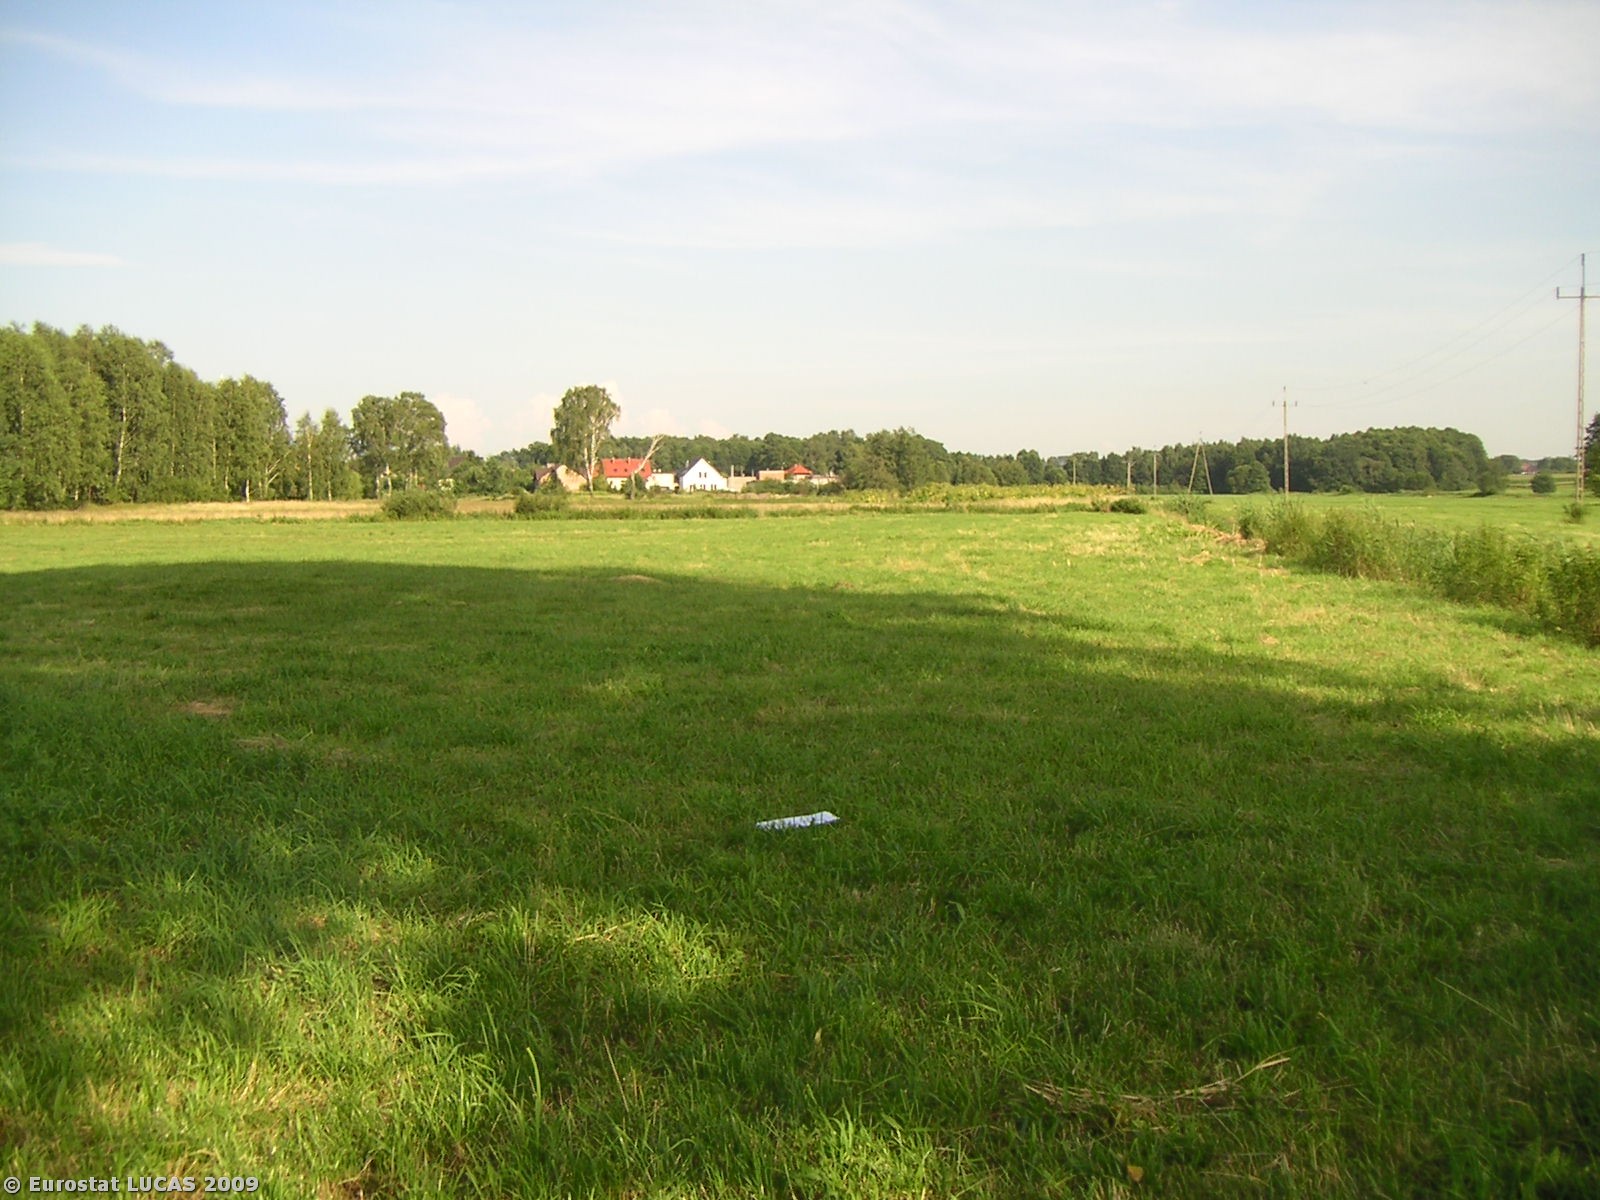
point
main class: Grassland
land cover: Grassland without tree/shrub cover
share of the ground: > 75 %
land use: Agriculture (excluding fallow land and kitchen gardens)
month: July
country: PL
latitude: 50.2226
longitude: 18.8096
